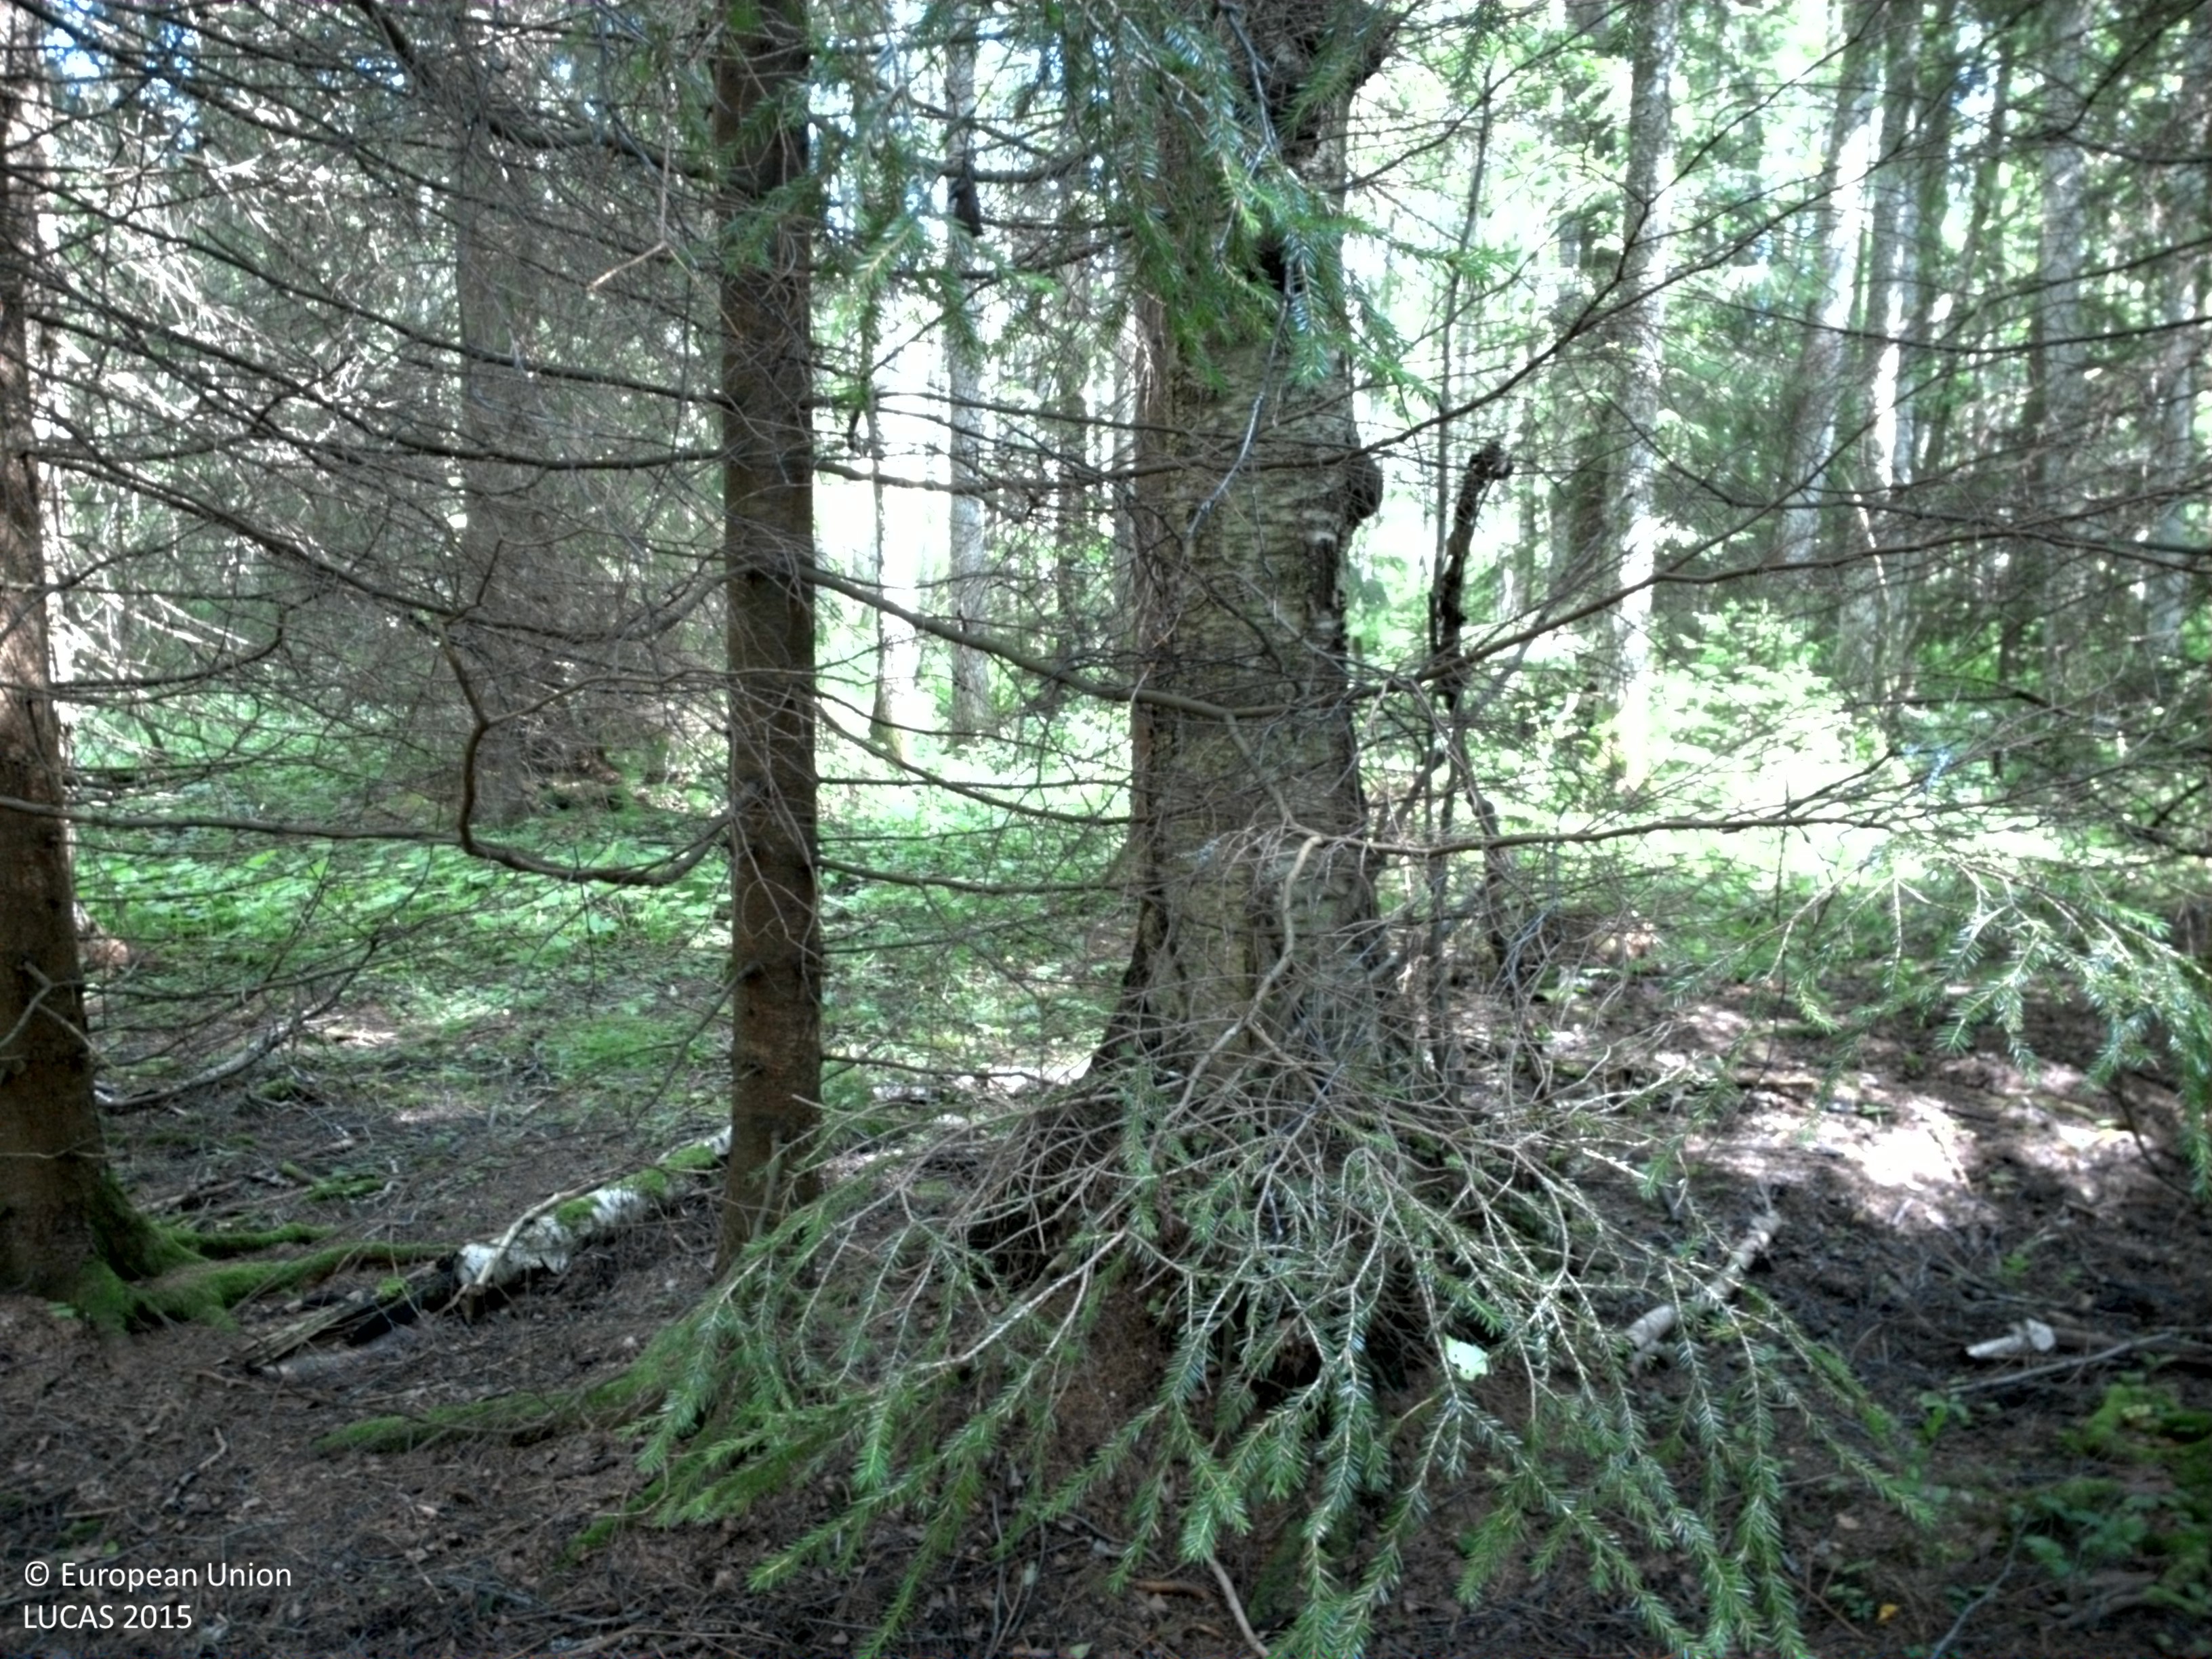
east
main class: Woodland
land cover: Spruce dominated coniferous woodland
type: boreal forest
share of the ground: 50 - 75 %
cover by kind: coniferous forest trees 60 %, unconsolidated bare surface 20 %, herbaceous plants 15 %, lichens and mosses 5 %
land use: Forestry
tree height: > 5 m
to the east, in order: Spruce dominated coniferous woodland; Broadleaved woodland; Ditches and canals; Broadleaved woodland; Tracks; Broadleaved woodland; Ditches and canals; Broadleaved woodland; Temporary grasslands; Broadleaved woodland; Temporary grasslands; Broadleaved woodland; Pine dominated coniferous woodland
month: July
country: SE
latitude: 58.7932
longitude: 15.4786
